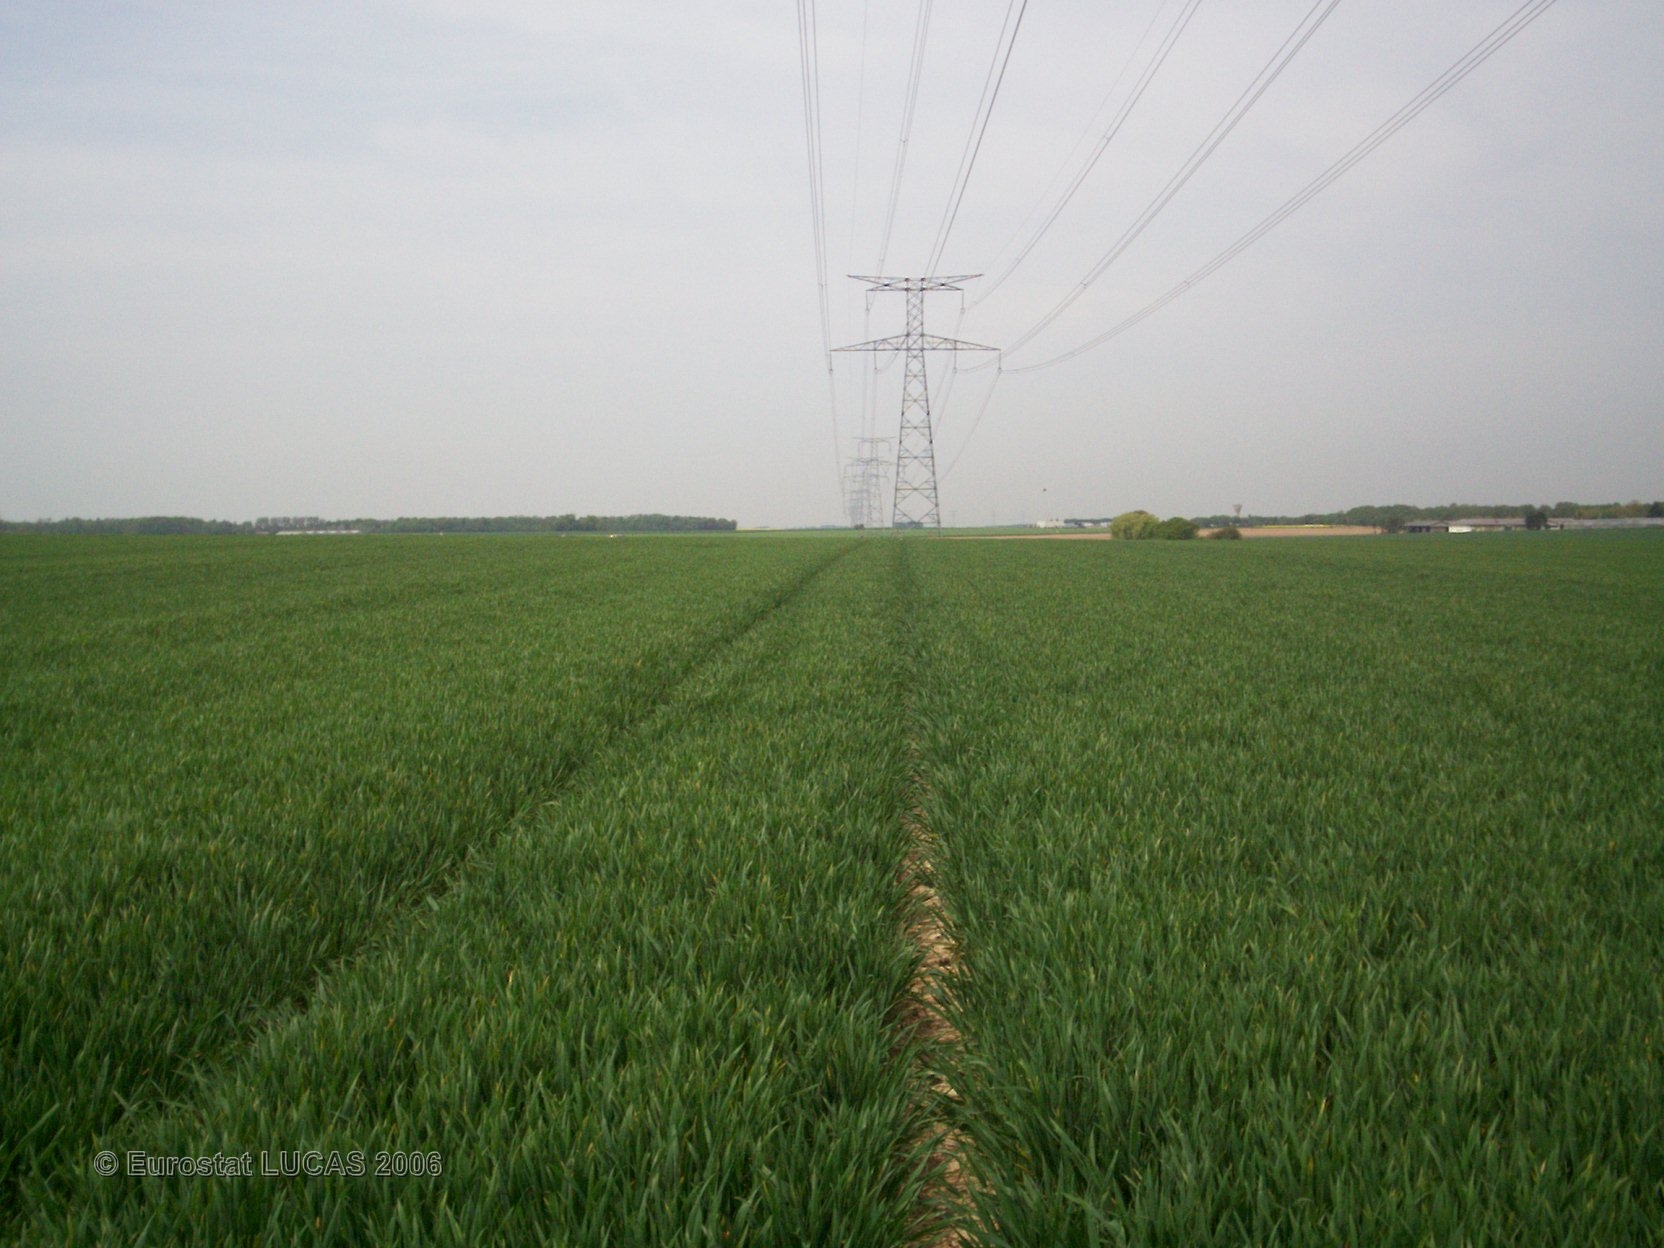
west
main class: Cropland
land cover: Common wheat
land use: Agriculture (excluding fallow land and kitchen gardens)
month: May
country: FR
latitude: 48.6229
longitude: 2.8413
